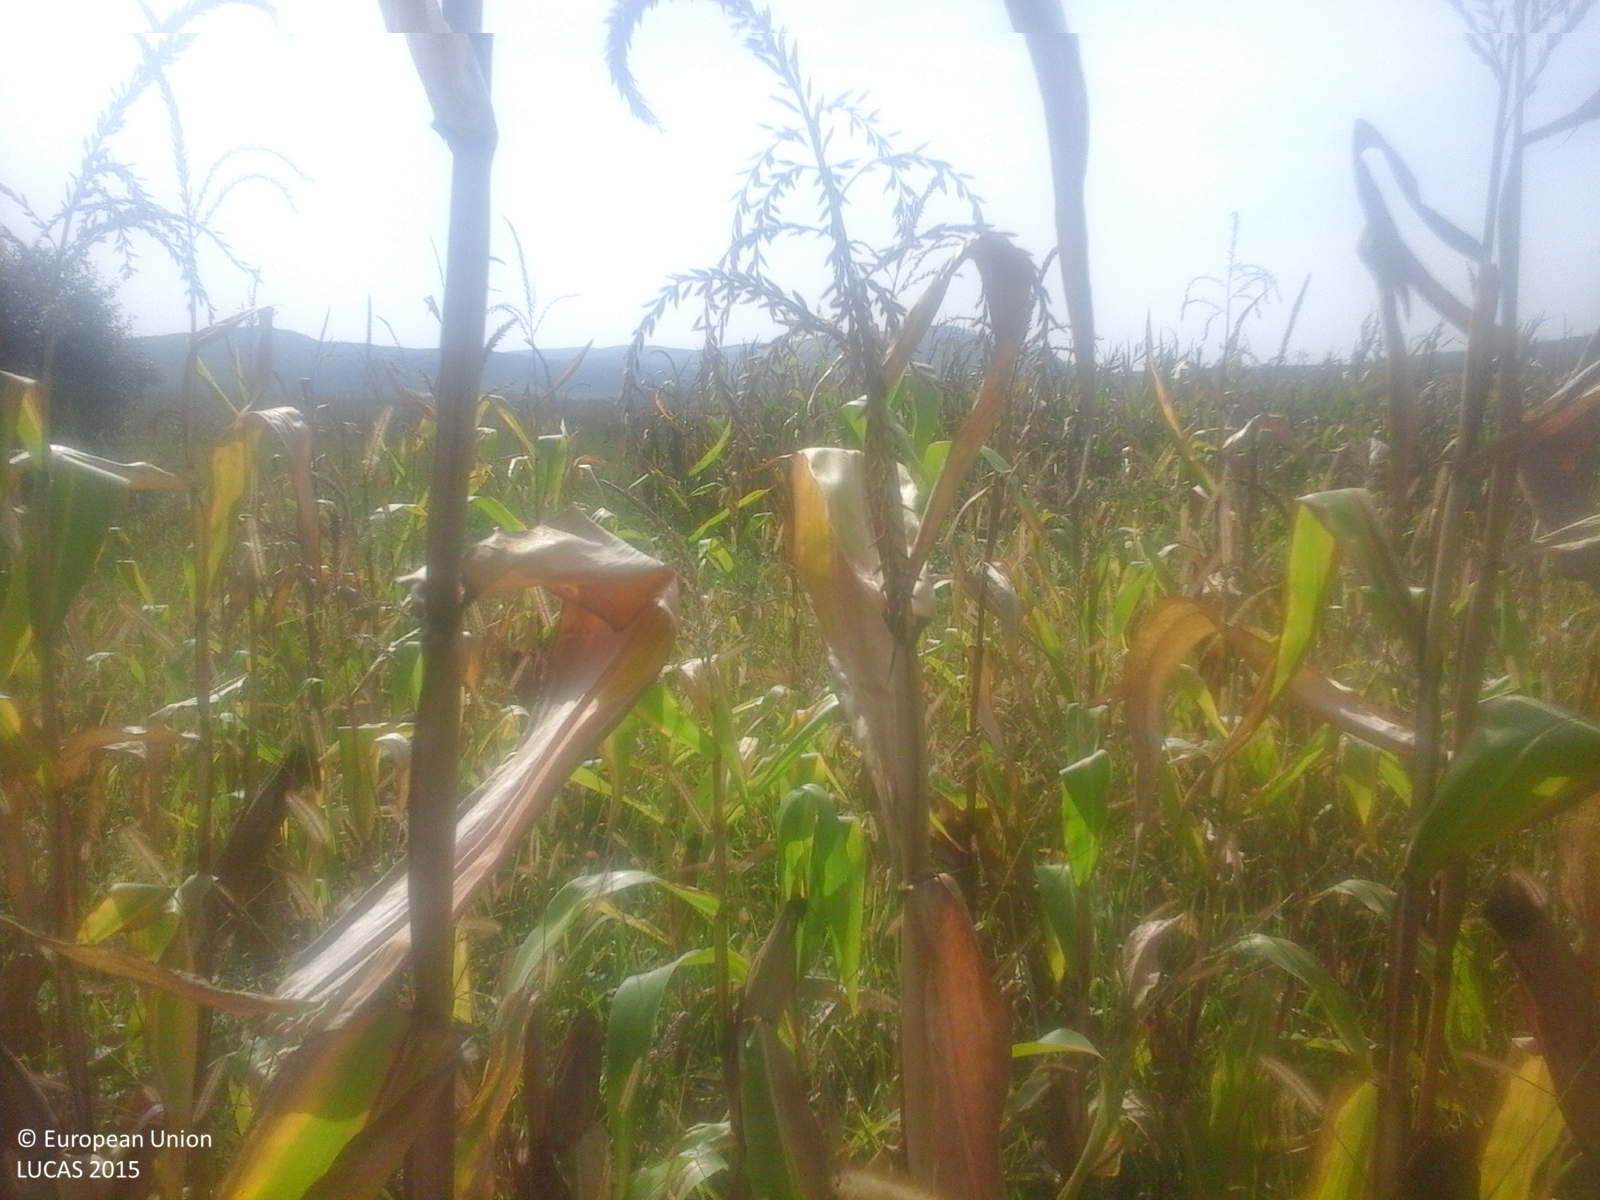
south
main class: Cropland
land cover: Maize
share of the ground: > 75 %
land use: Agriculture (excluding fallow land and kitchen gardens)
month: September
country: RO
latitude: 47.0421
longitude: 24.3410
